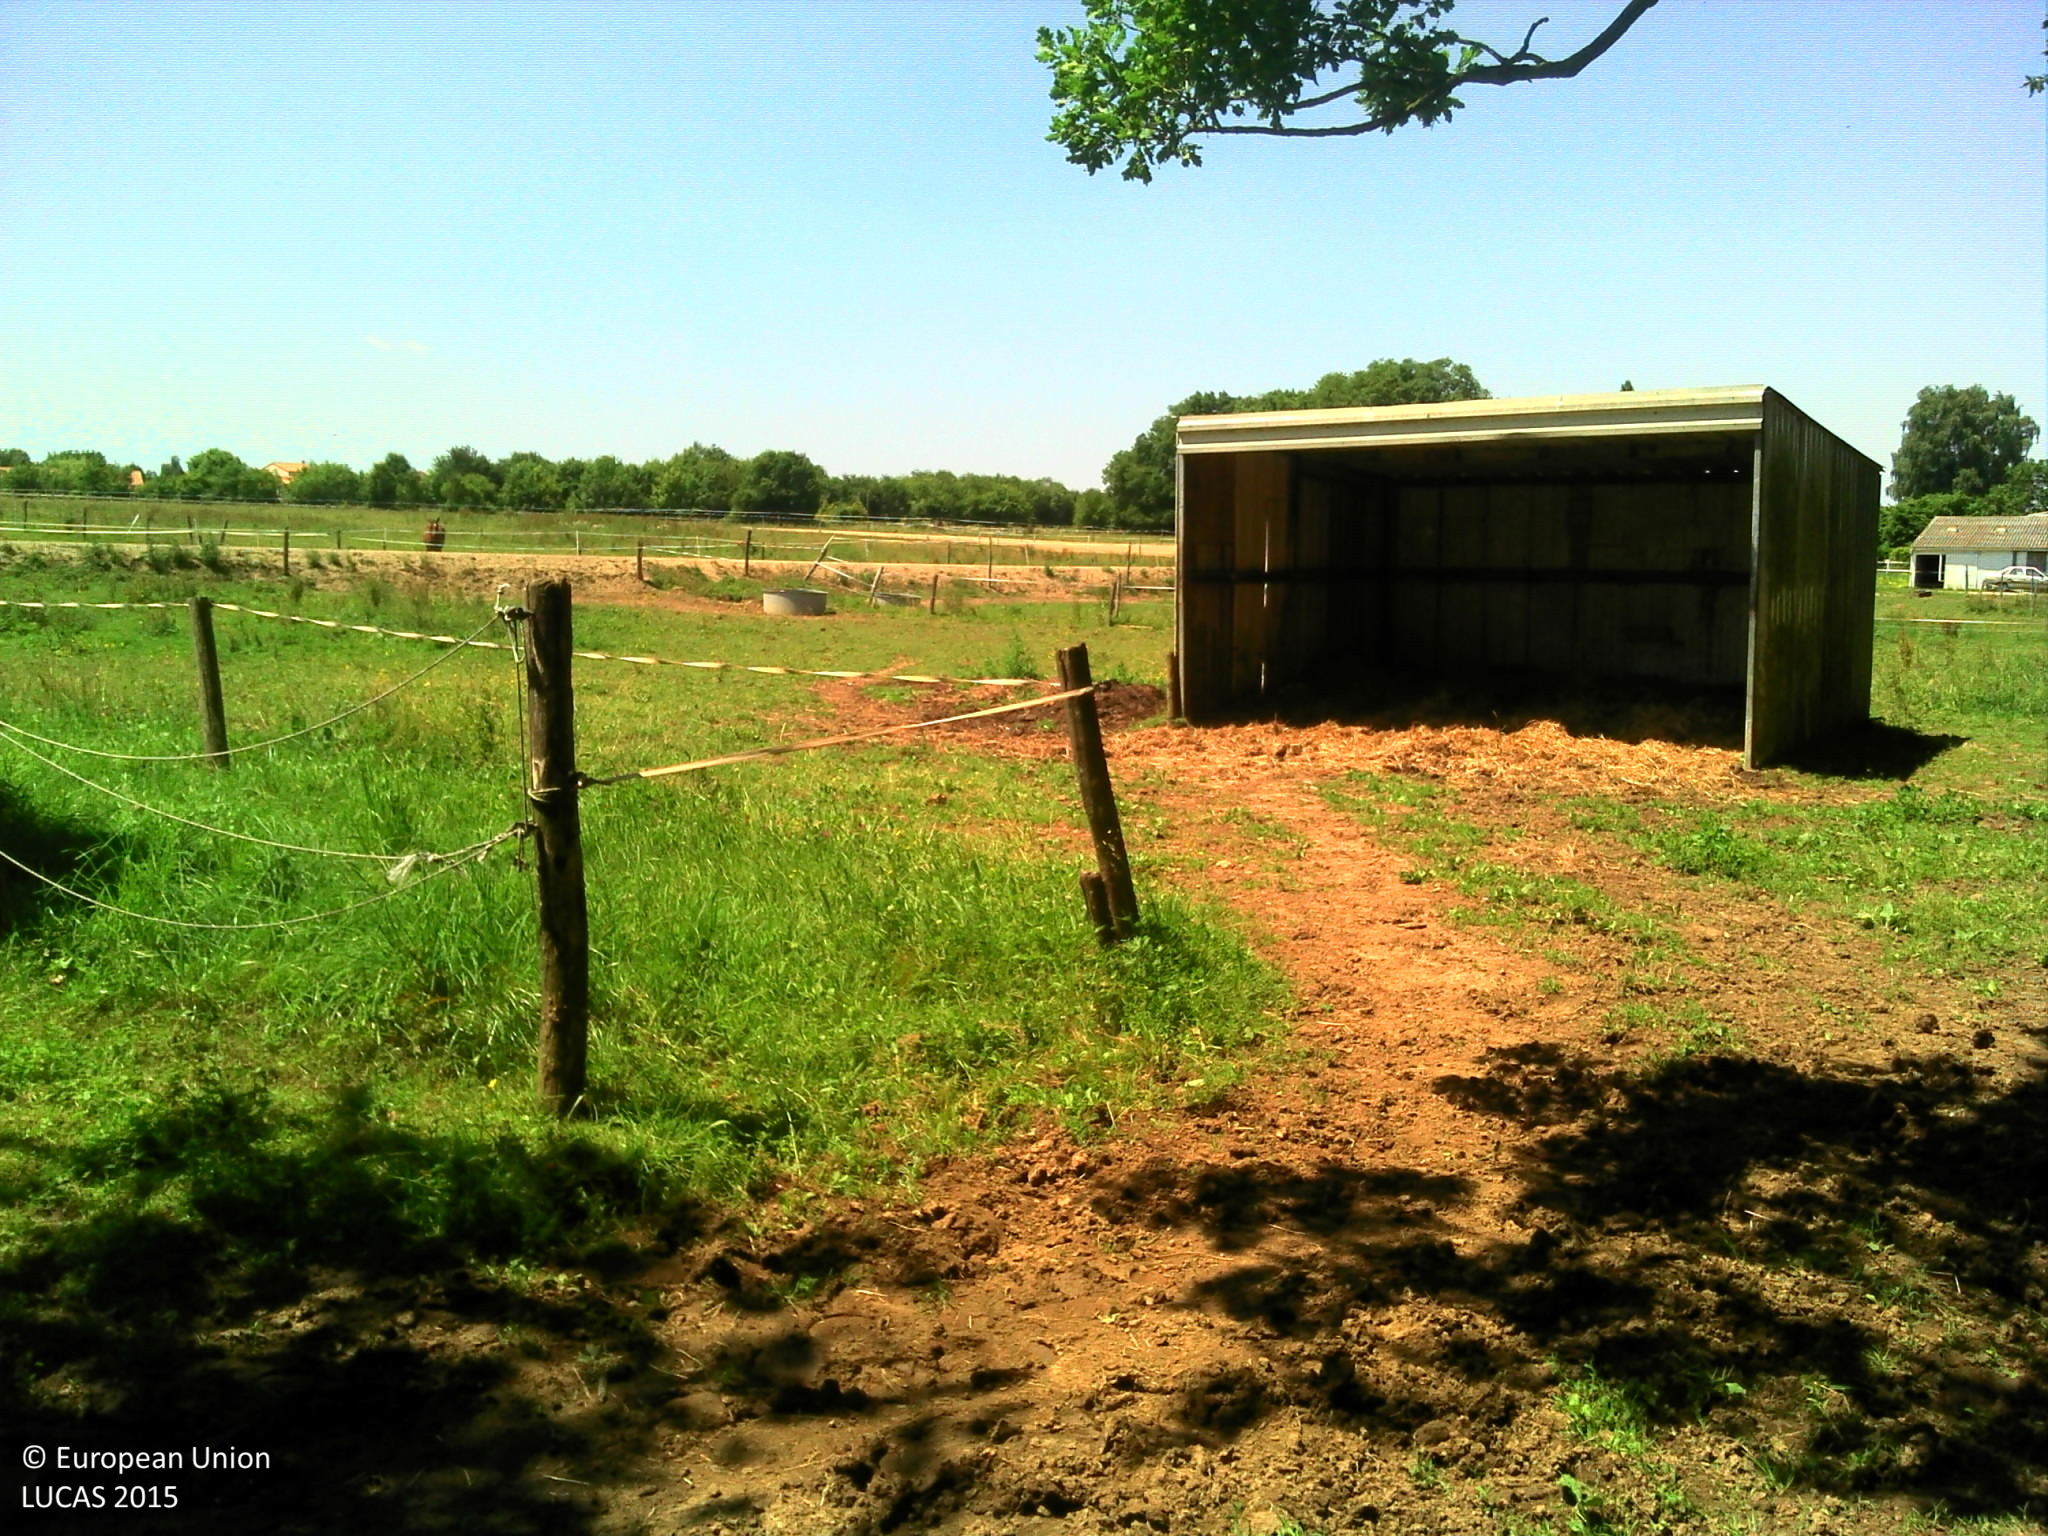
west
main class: Grassland
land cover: Grassland without tree/shrub cover
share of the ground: > 75 %
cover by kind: herbaceous plants 100 %
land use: Sport
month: June
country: FR
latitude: 46.8177
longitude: -1.3486
